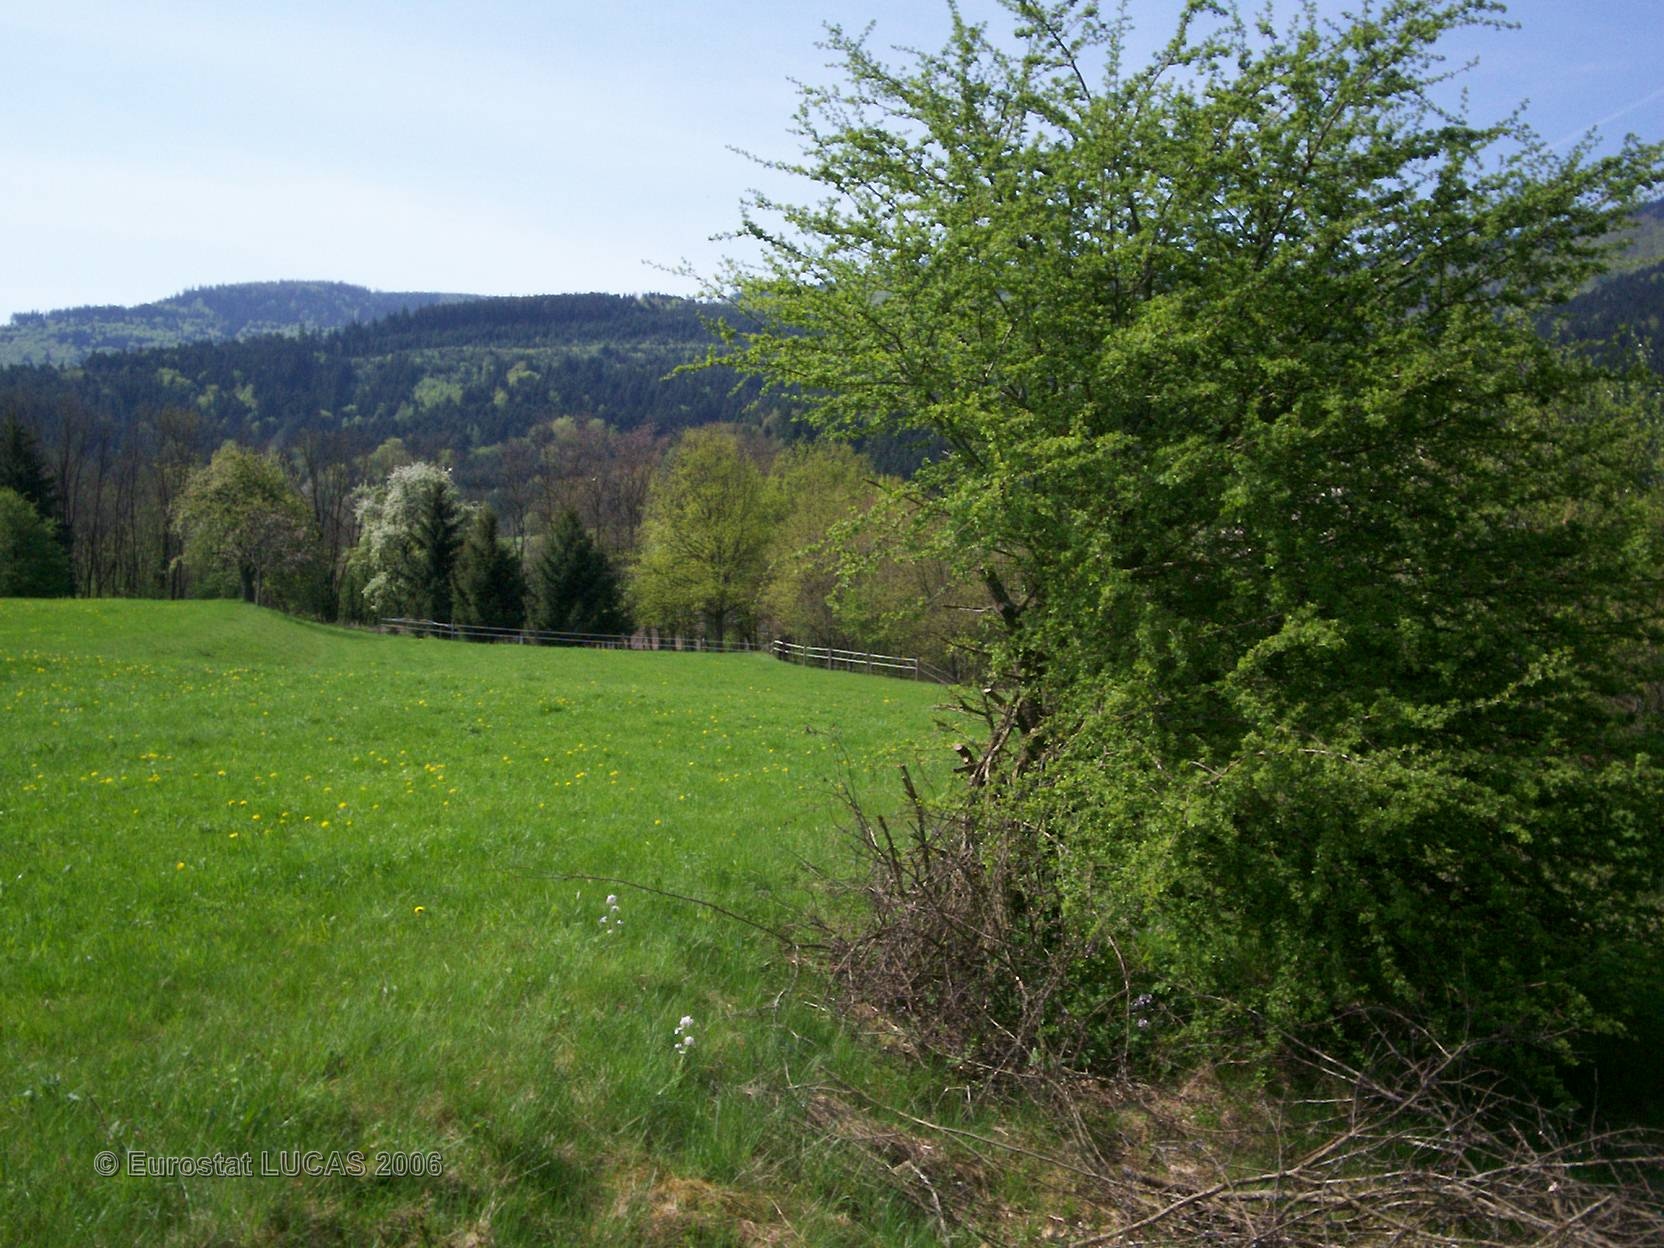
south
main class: Grassland
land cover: Grassland with sparse tree/shrub cover
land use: Agriculture (excluding fallow land and kitchen gardens)
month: May
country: FR
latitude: 47.7858
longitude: 6.9715
